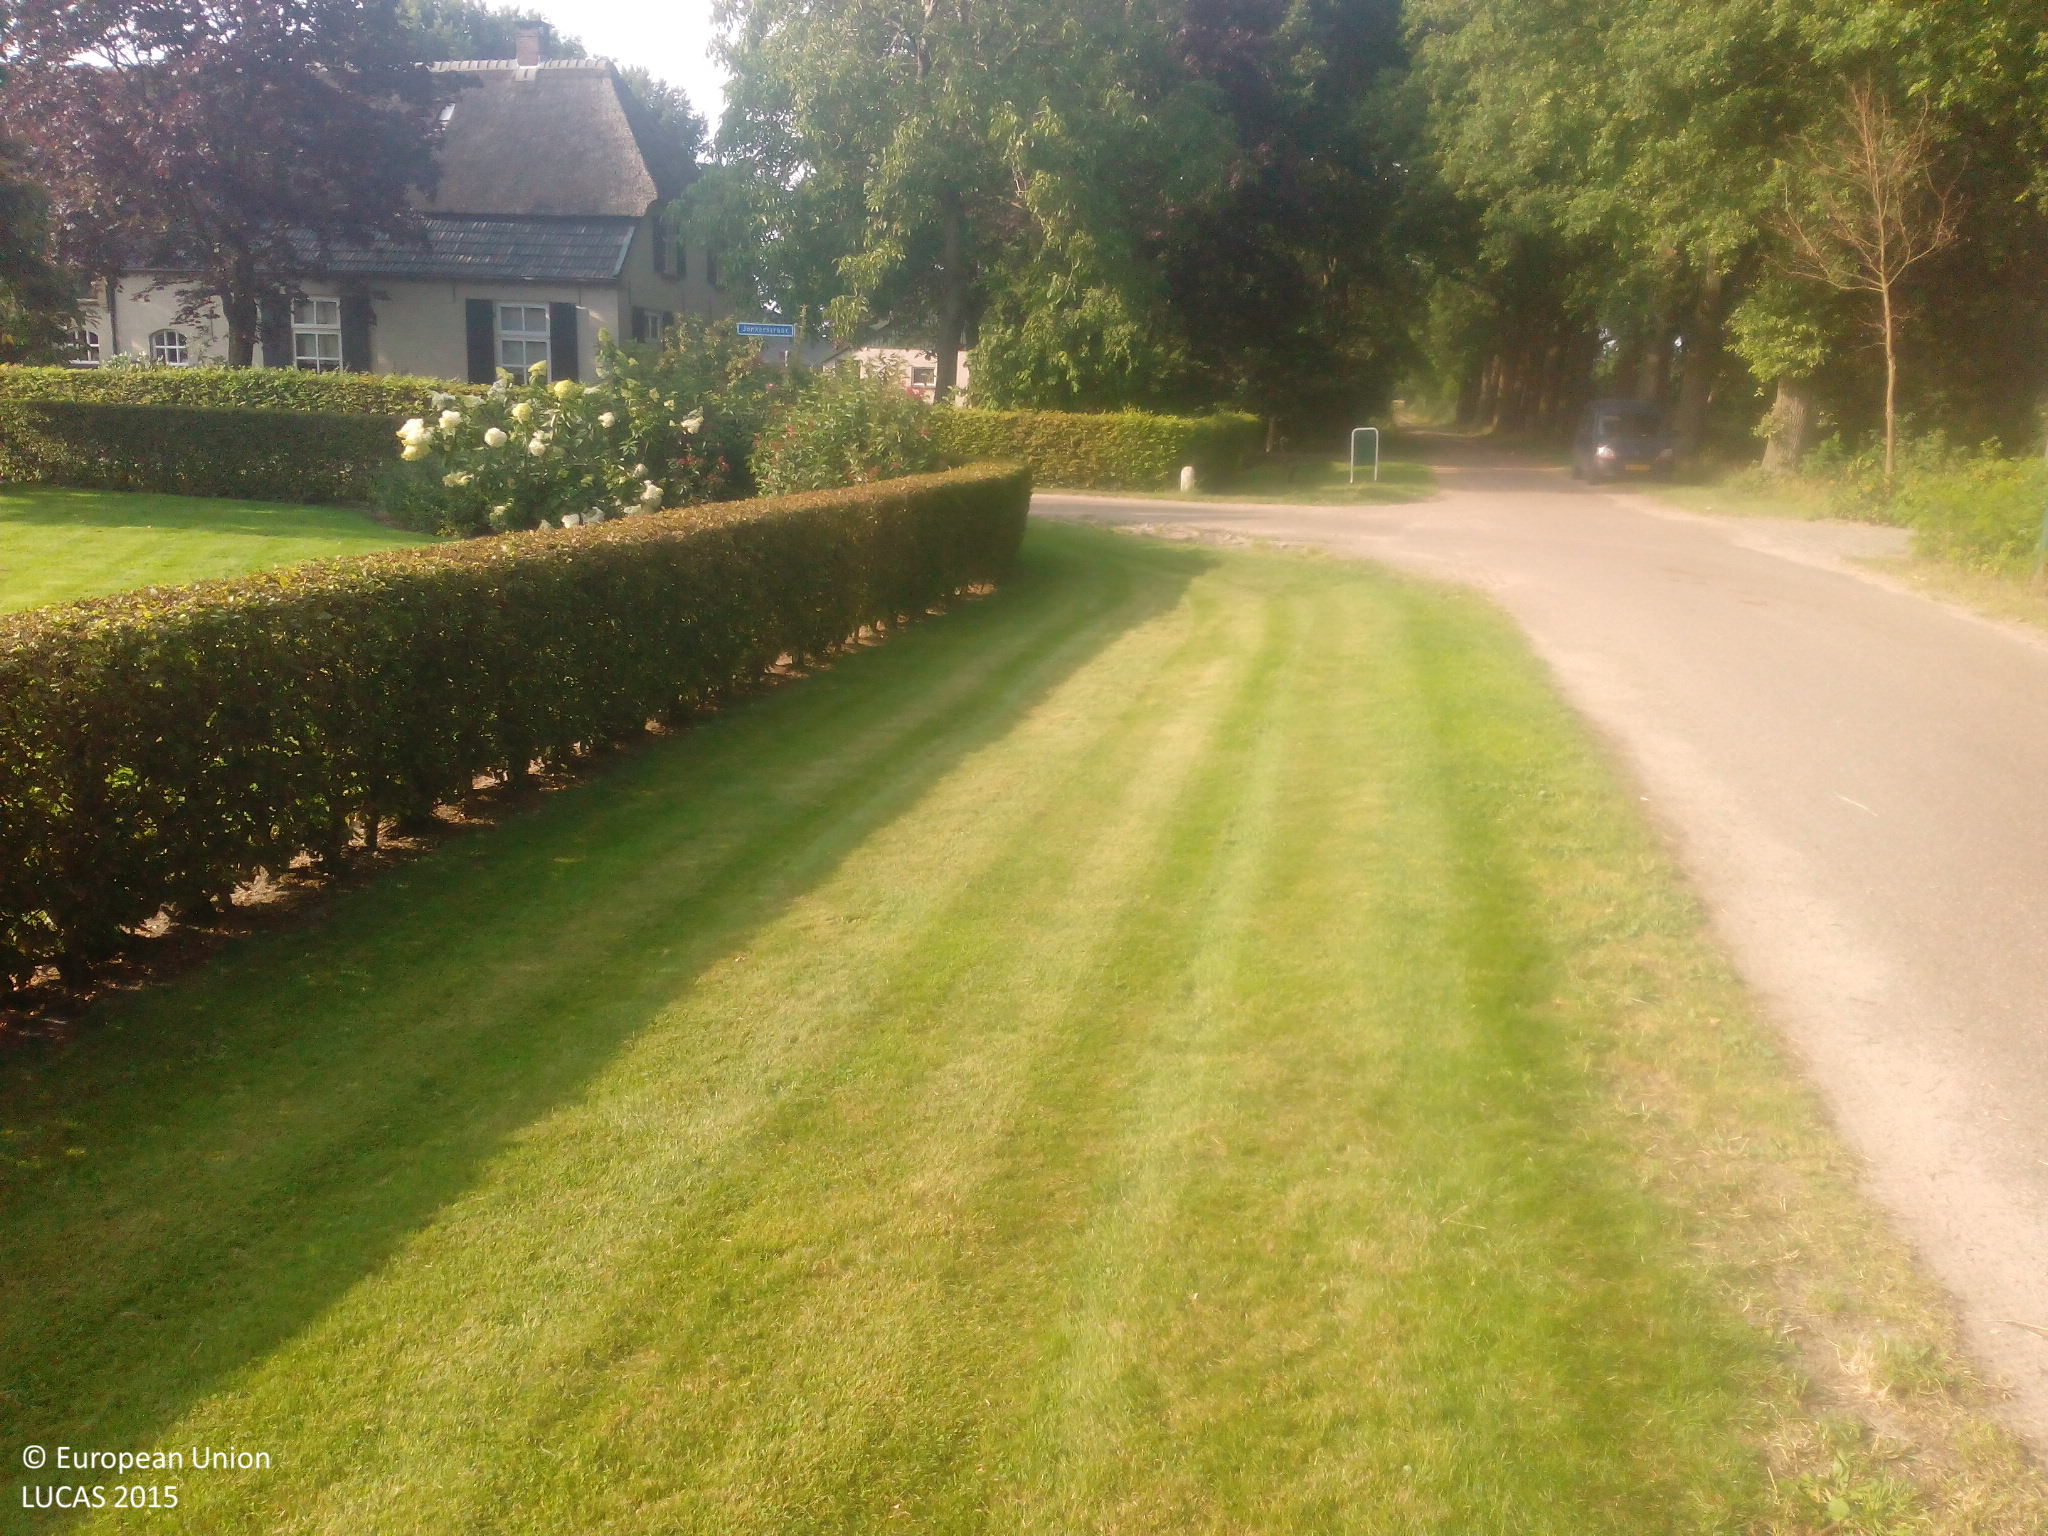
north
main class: Grassland
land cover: Grassland with sparse tree/shrub cover
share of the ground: > 75 %
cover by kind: herbaceous plants 95 %, broadleaved forest trees 5 %
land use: Residential
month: August
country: NL
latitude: 51.7160
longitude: 5.4967
